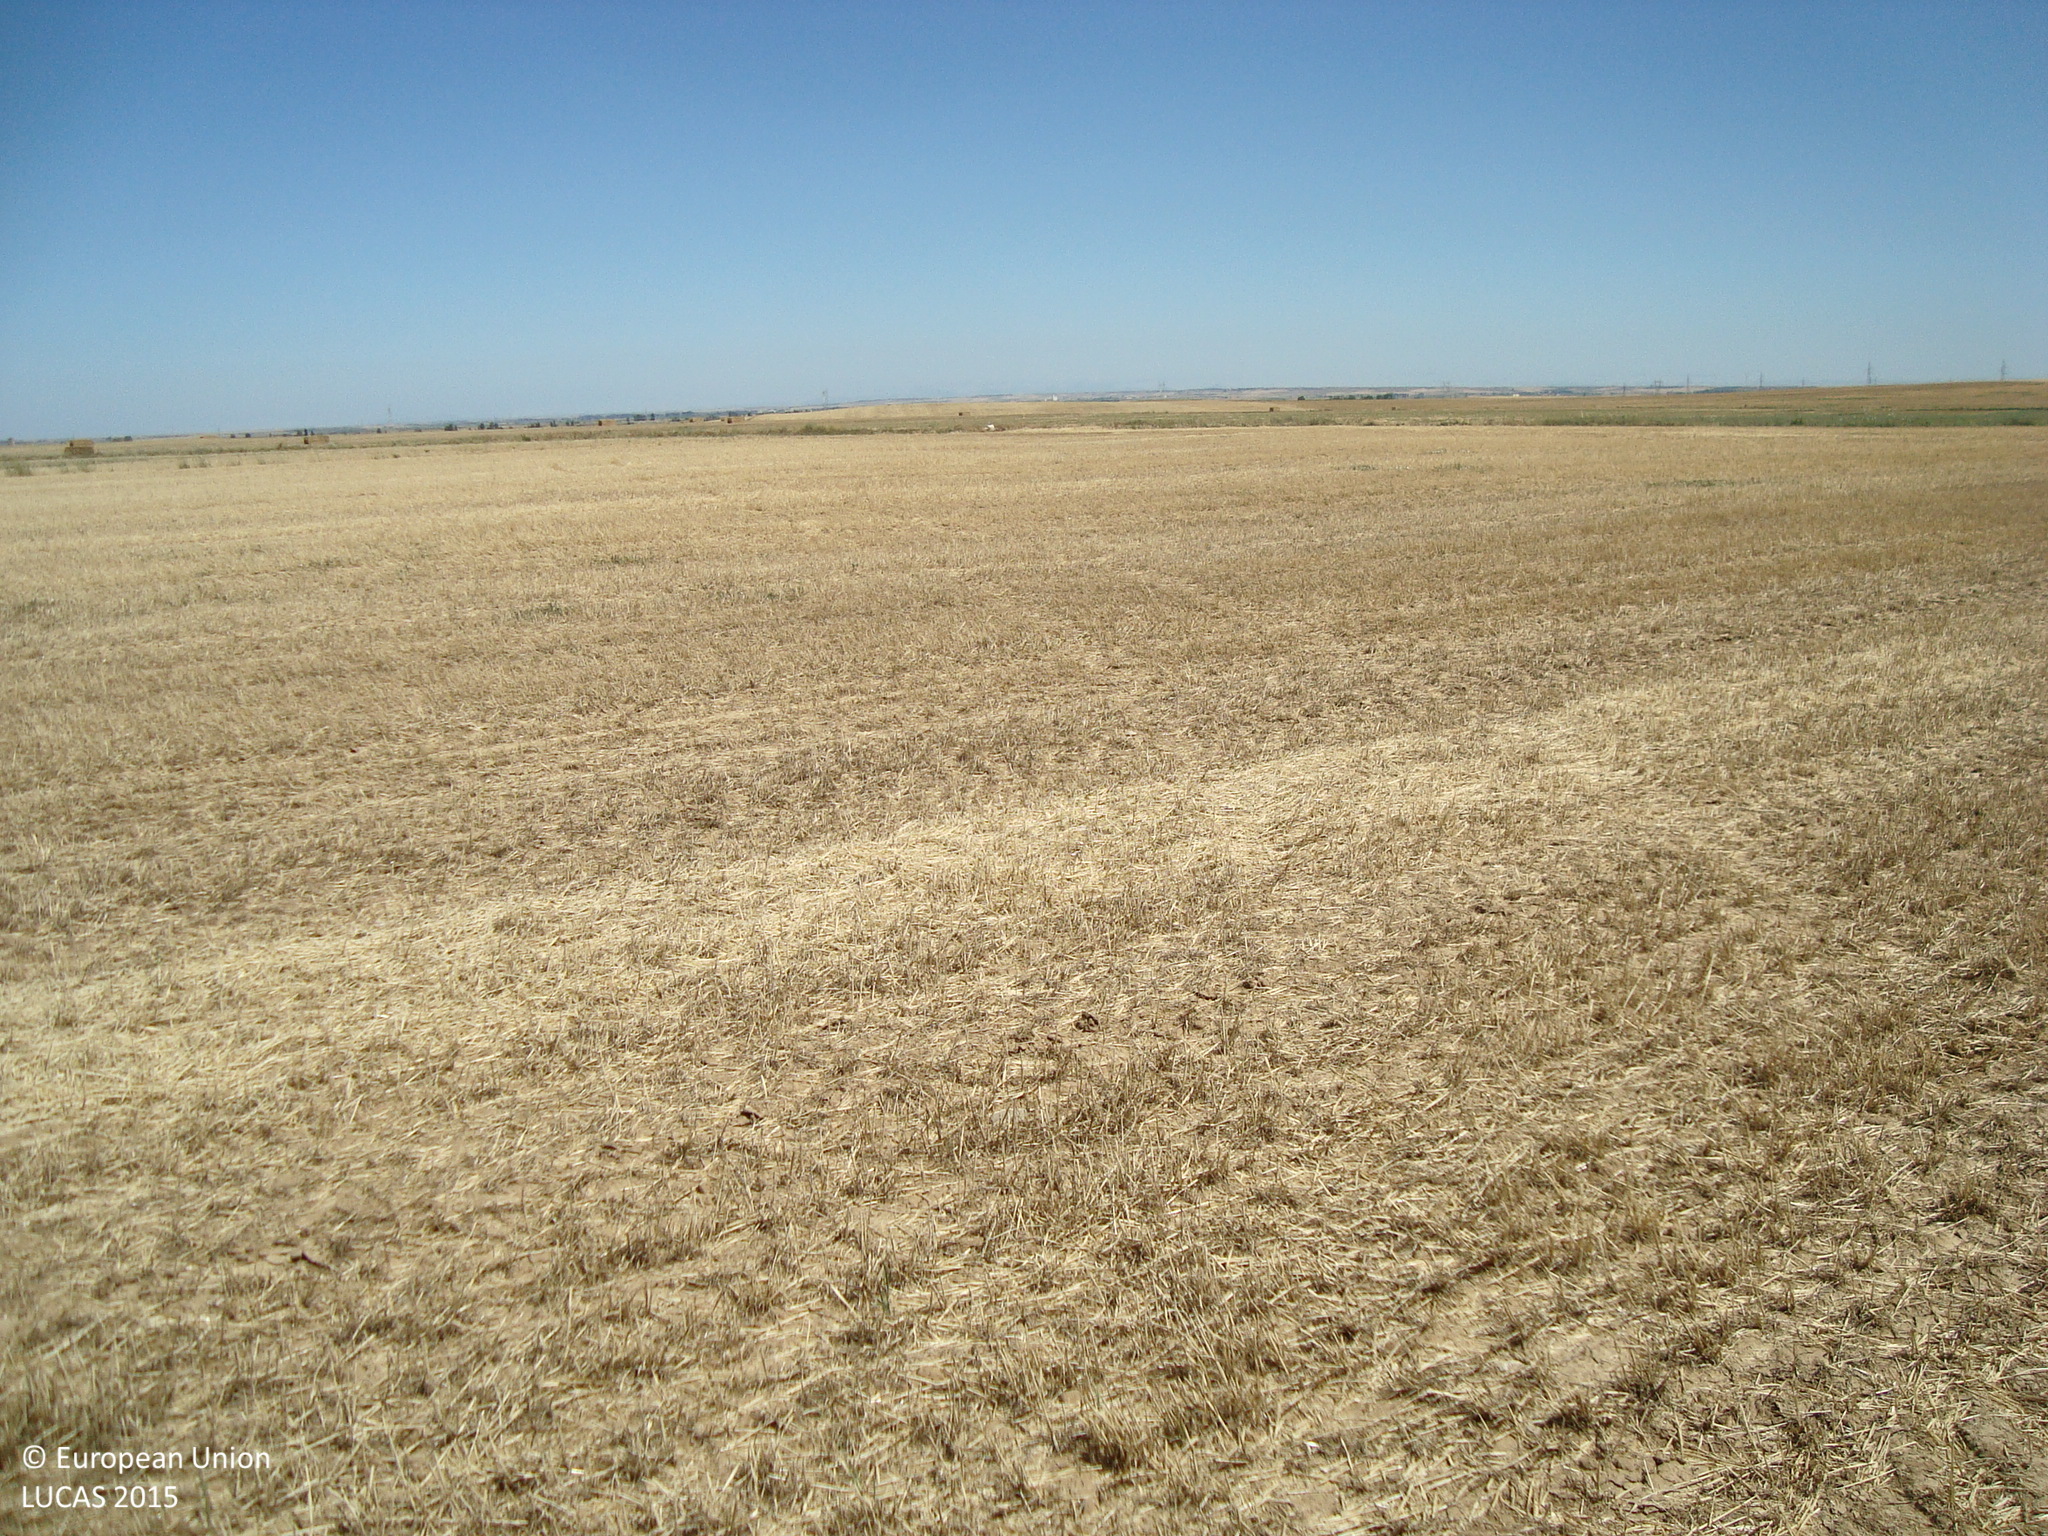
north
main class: Cropland
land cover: Barley
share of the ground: < 10 %
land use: Agriculture (excluding fallow land and kitchen gardens)
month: July
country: ES
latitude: 41.9974
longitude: -4.6924
